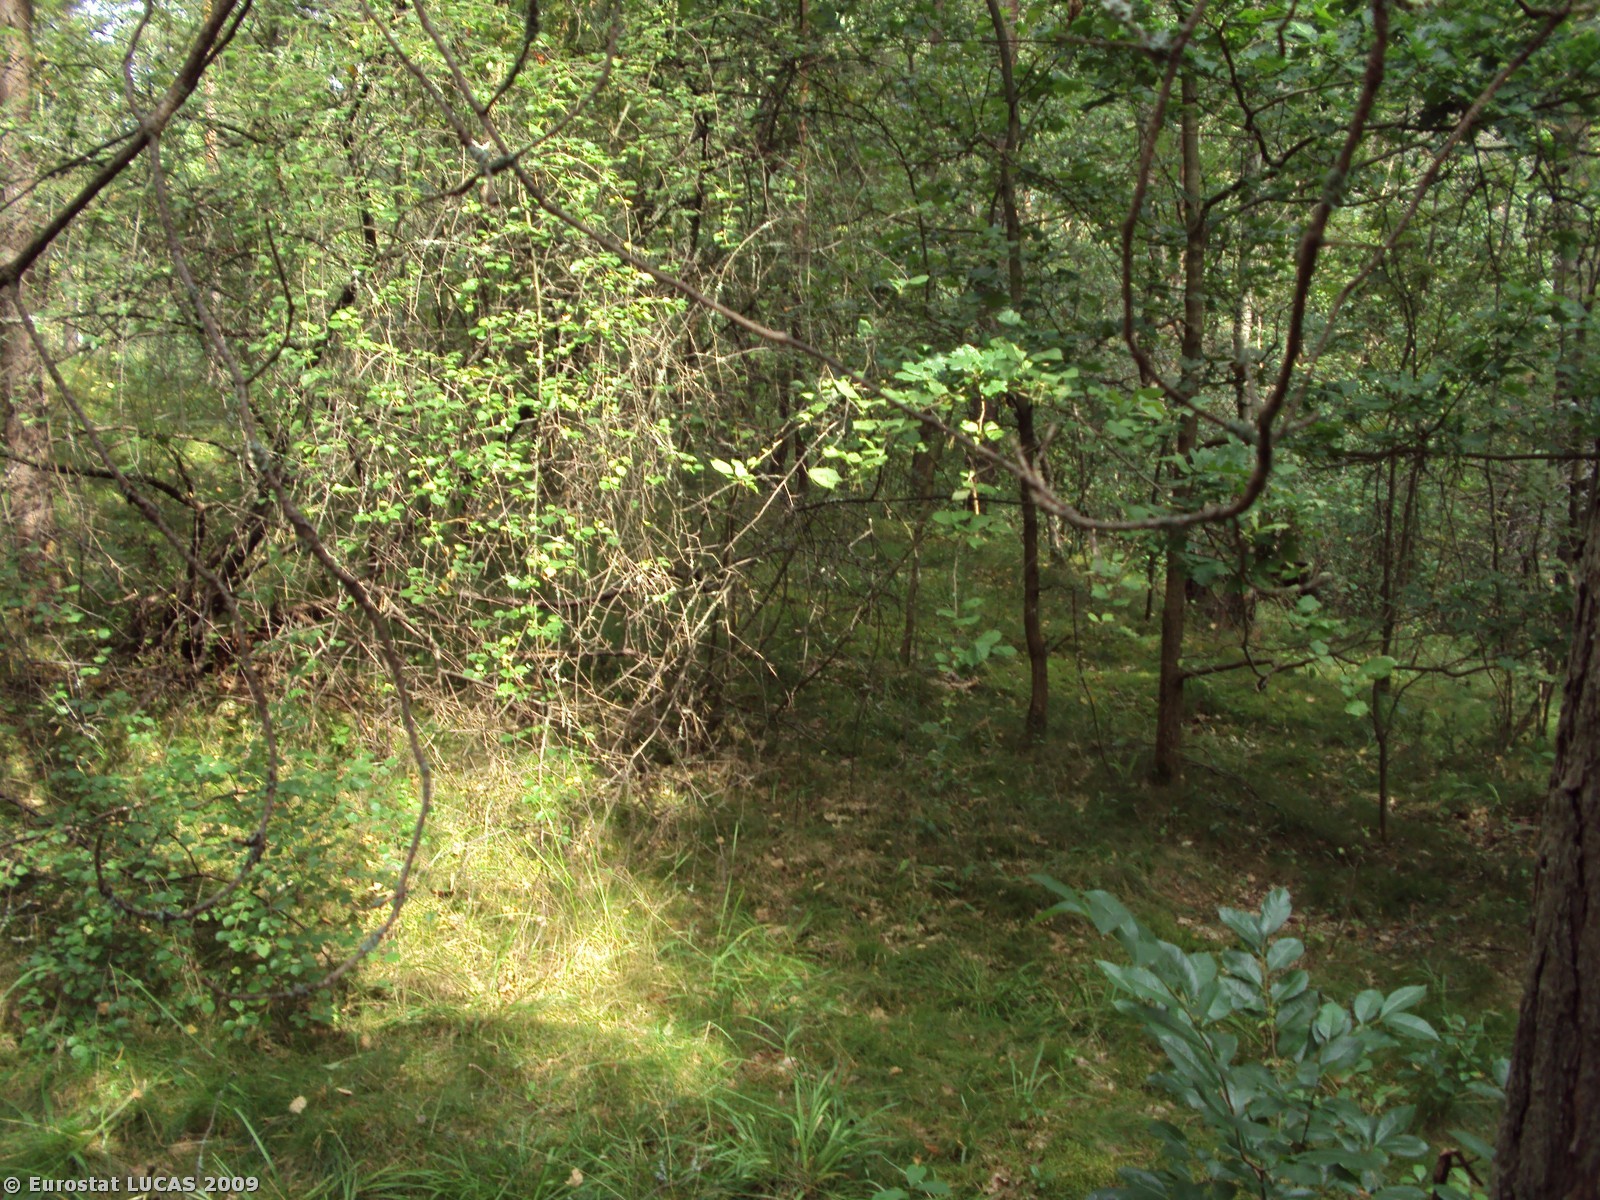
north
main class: Woodland
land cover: Mixed woodland
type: hemiboreal forest and nemoral coniferous forest and mixed broadleaved-coniferous forest
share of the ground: > 75 %
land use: Forestry
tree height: > 5 m
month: August
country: PL
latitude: 53.5871
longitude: 16.5177
